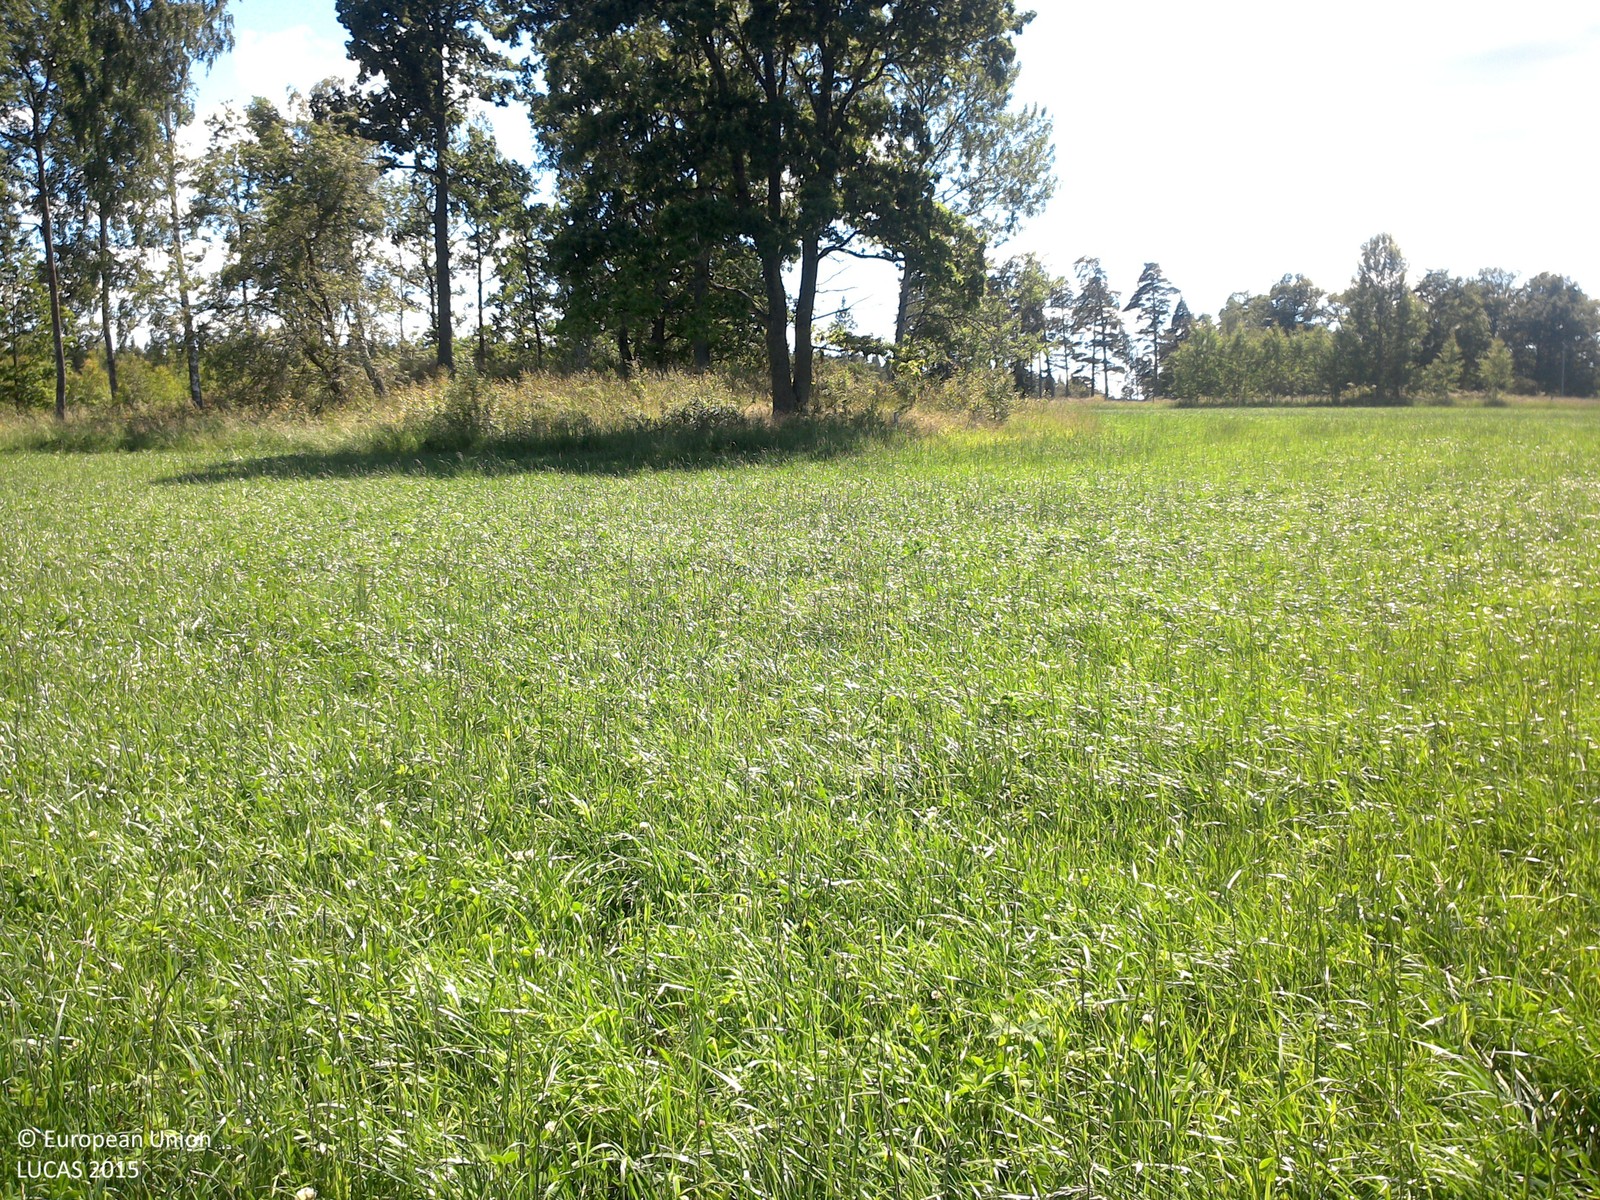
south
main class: Cropland
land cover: Other leguminous and mixtures for fodder
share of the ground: > 75 %
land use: Agriculture (excluding fallow land and kitchen gardens)
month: July
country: SE
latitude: 58.3258
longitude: 15.4414
